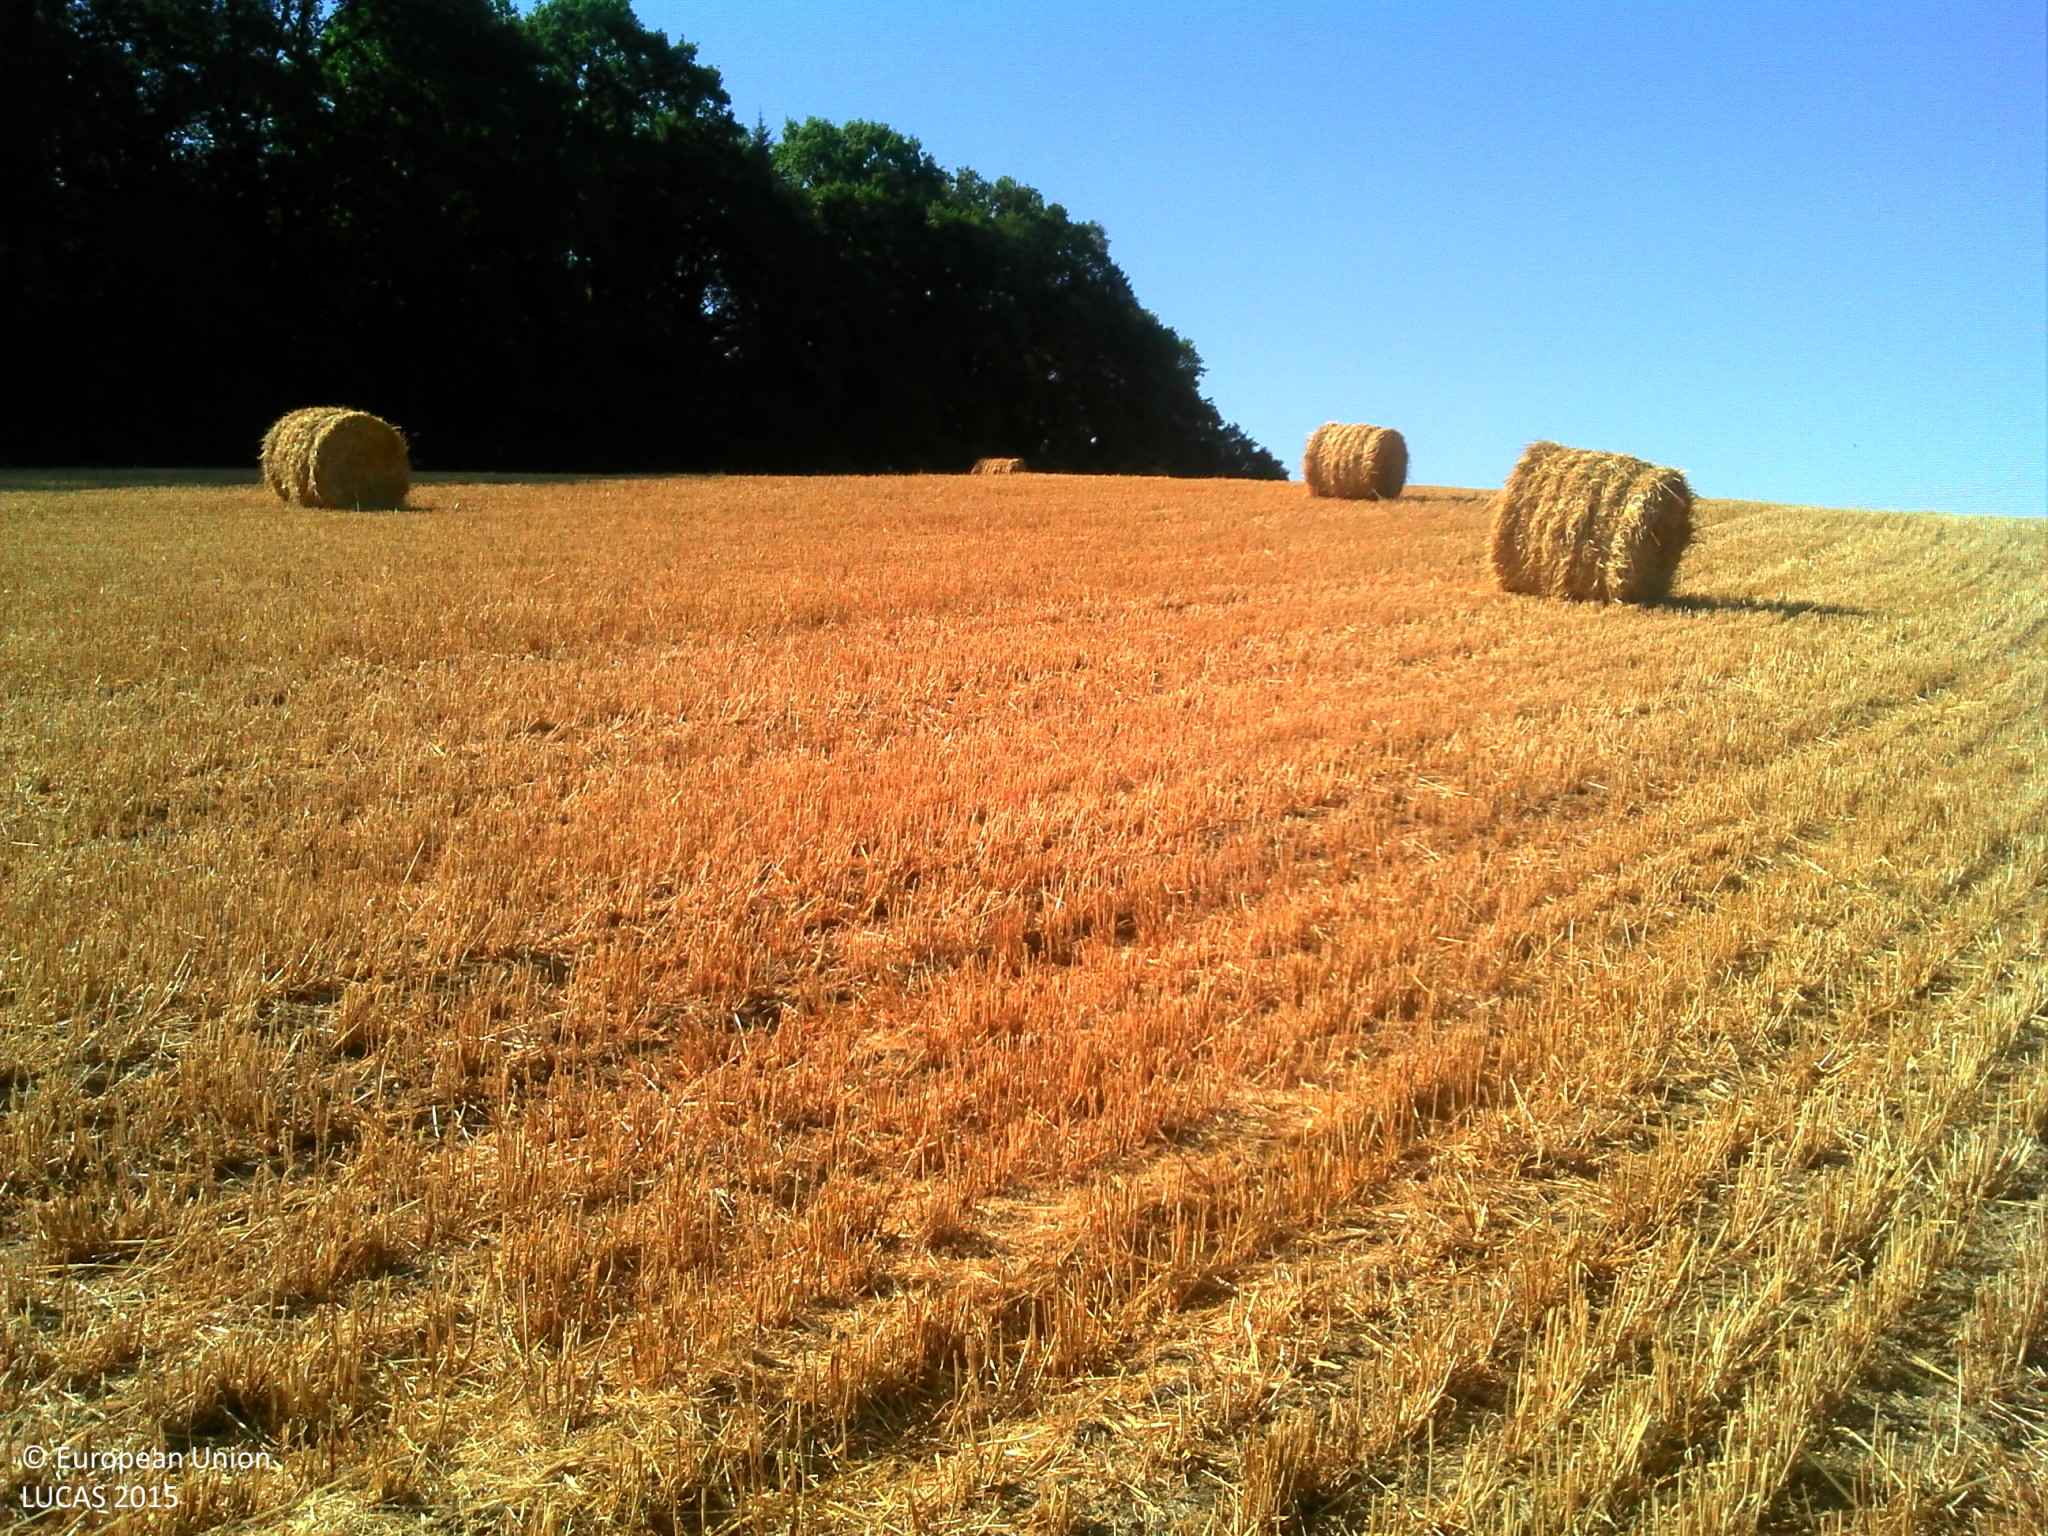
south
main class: Cropland
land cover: Durum wheat
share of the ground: > 75 %
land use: Agriculture (excluding fallow land and kitchen gardens)
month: July
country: FR
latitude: 45.6112
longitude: 1.4657
